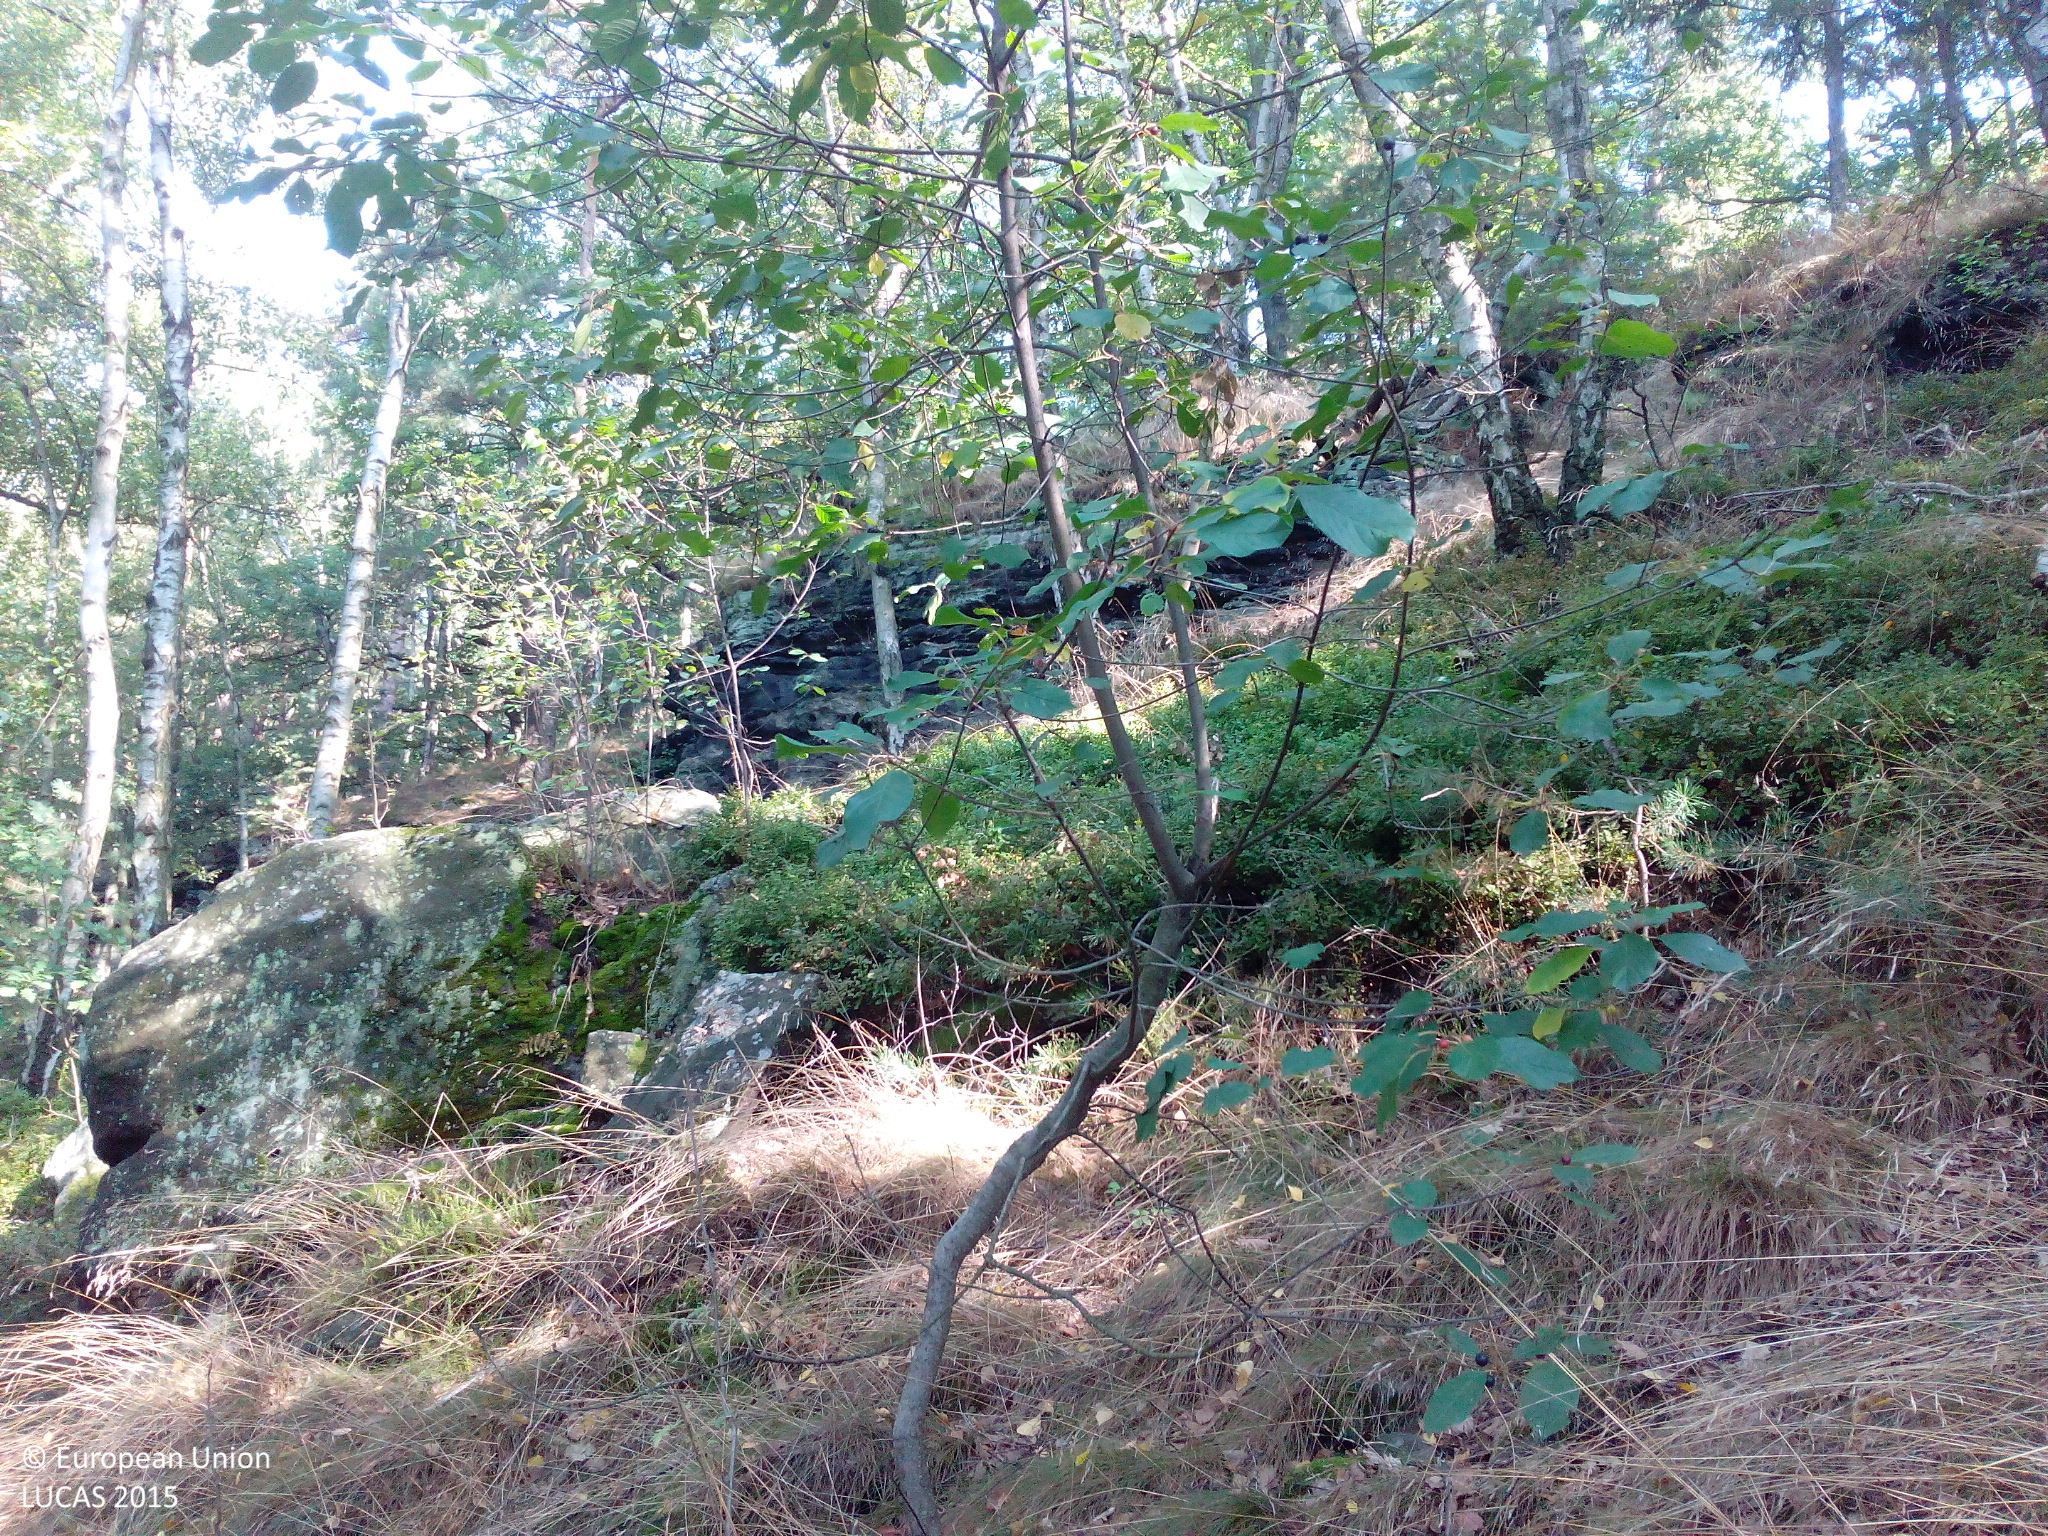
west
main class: Woodland
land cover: Pine dominated mixed woodland
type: hemiboreal forest and nemoral coniferous forest and mixed broadleaved-coniferous forest
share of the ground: > 75 %
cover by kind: coniferous forest trees 60 %, broadleaved forest trees 40 %
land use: Forestry
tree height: > 5 m
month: August
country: DE
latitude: 50.9063
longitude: 13.9971
